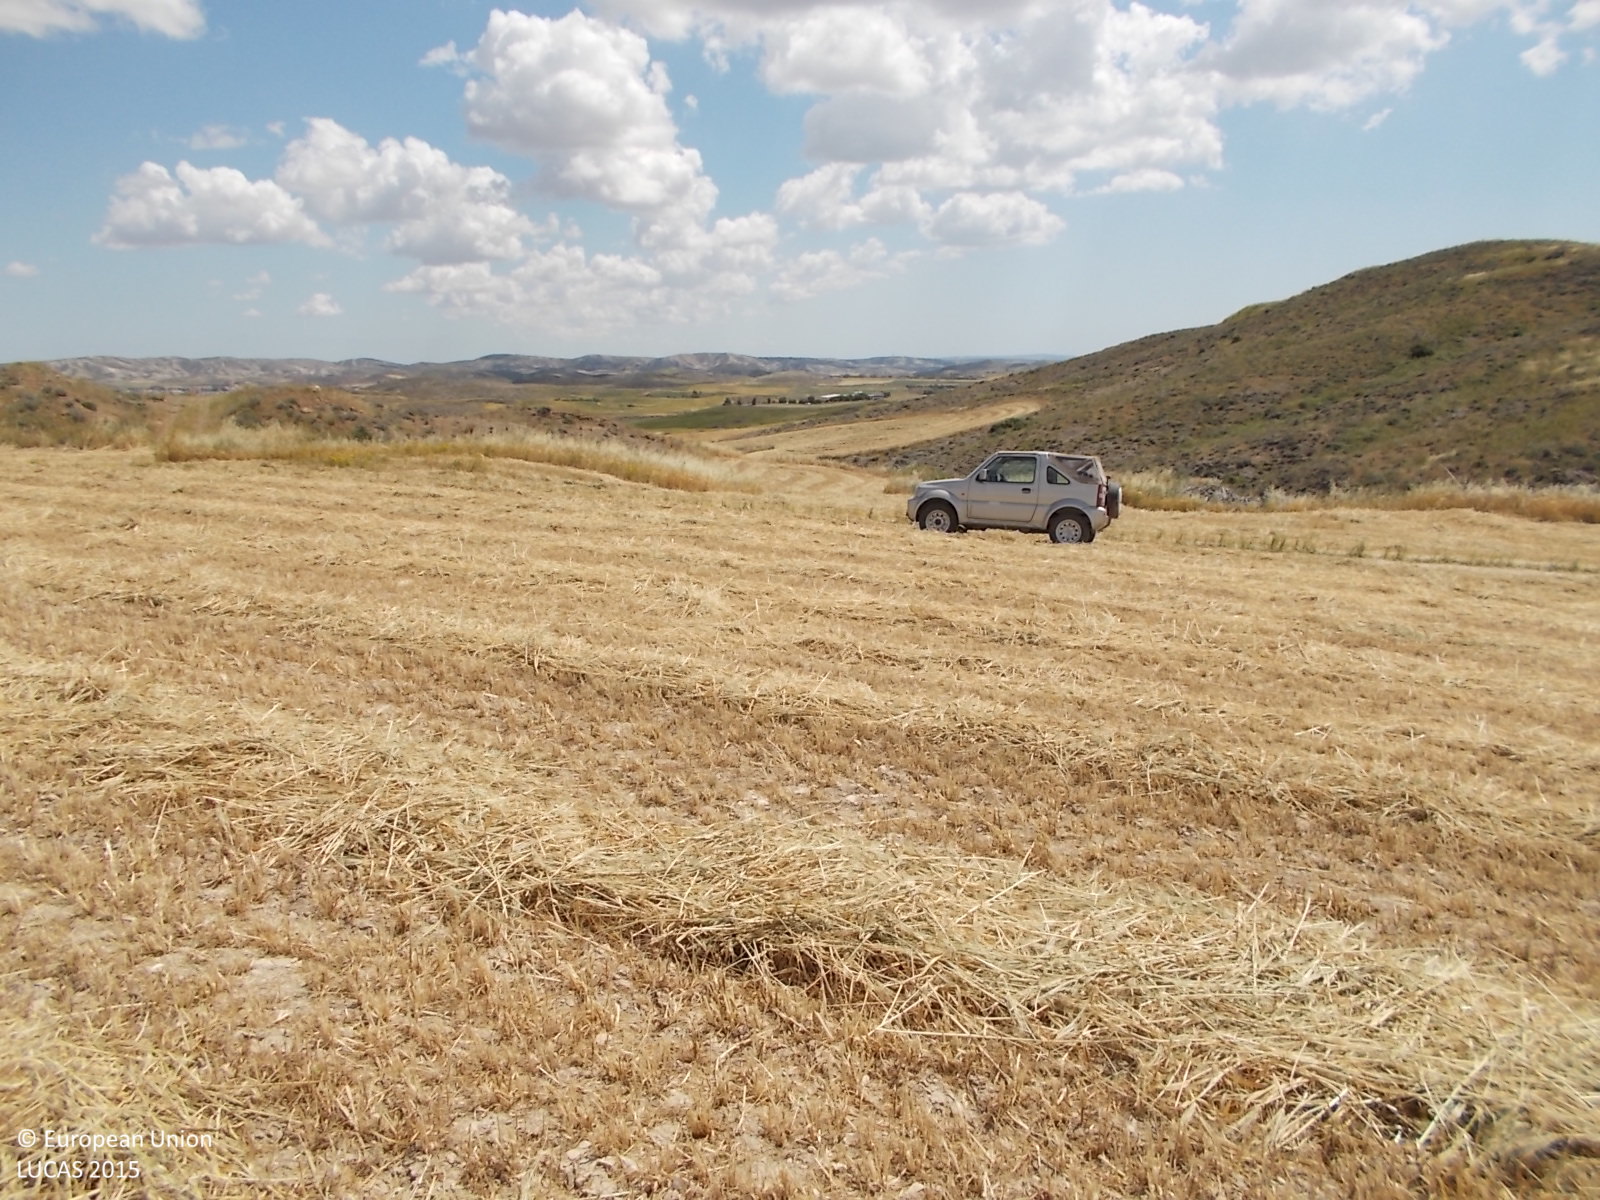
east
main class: Cropland
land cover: Mixed cereals for fodder
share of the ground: < 10 %
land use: Agriculture (excluding fallow land and kitchen gardens)
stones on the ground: < 10 %
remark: Harvested field
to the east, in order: Mixed cereals for fodder; Tracks; Barley; Spontaneously vegetated surfaces; Oats; Shrubland without tree cover; Other bare soil; Shrubland without tree cover; Rocks and stones; Shrubland without tree cover
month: April
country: CY
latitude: 35.0207
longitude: 33.5744
